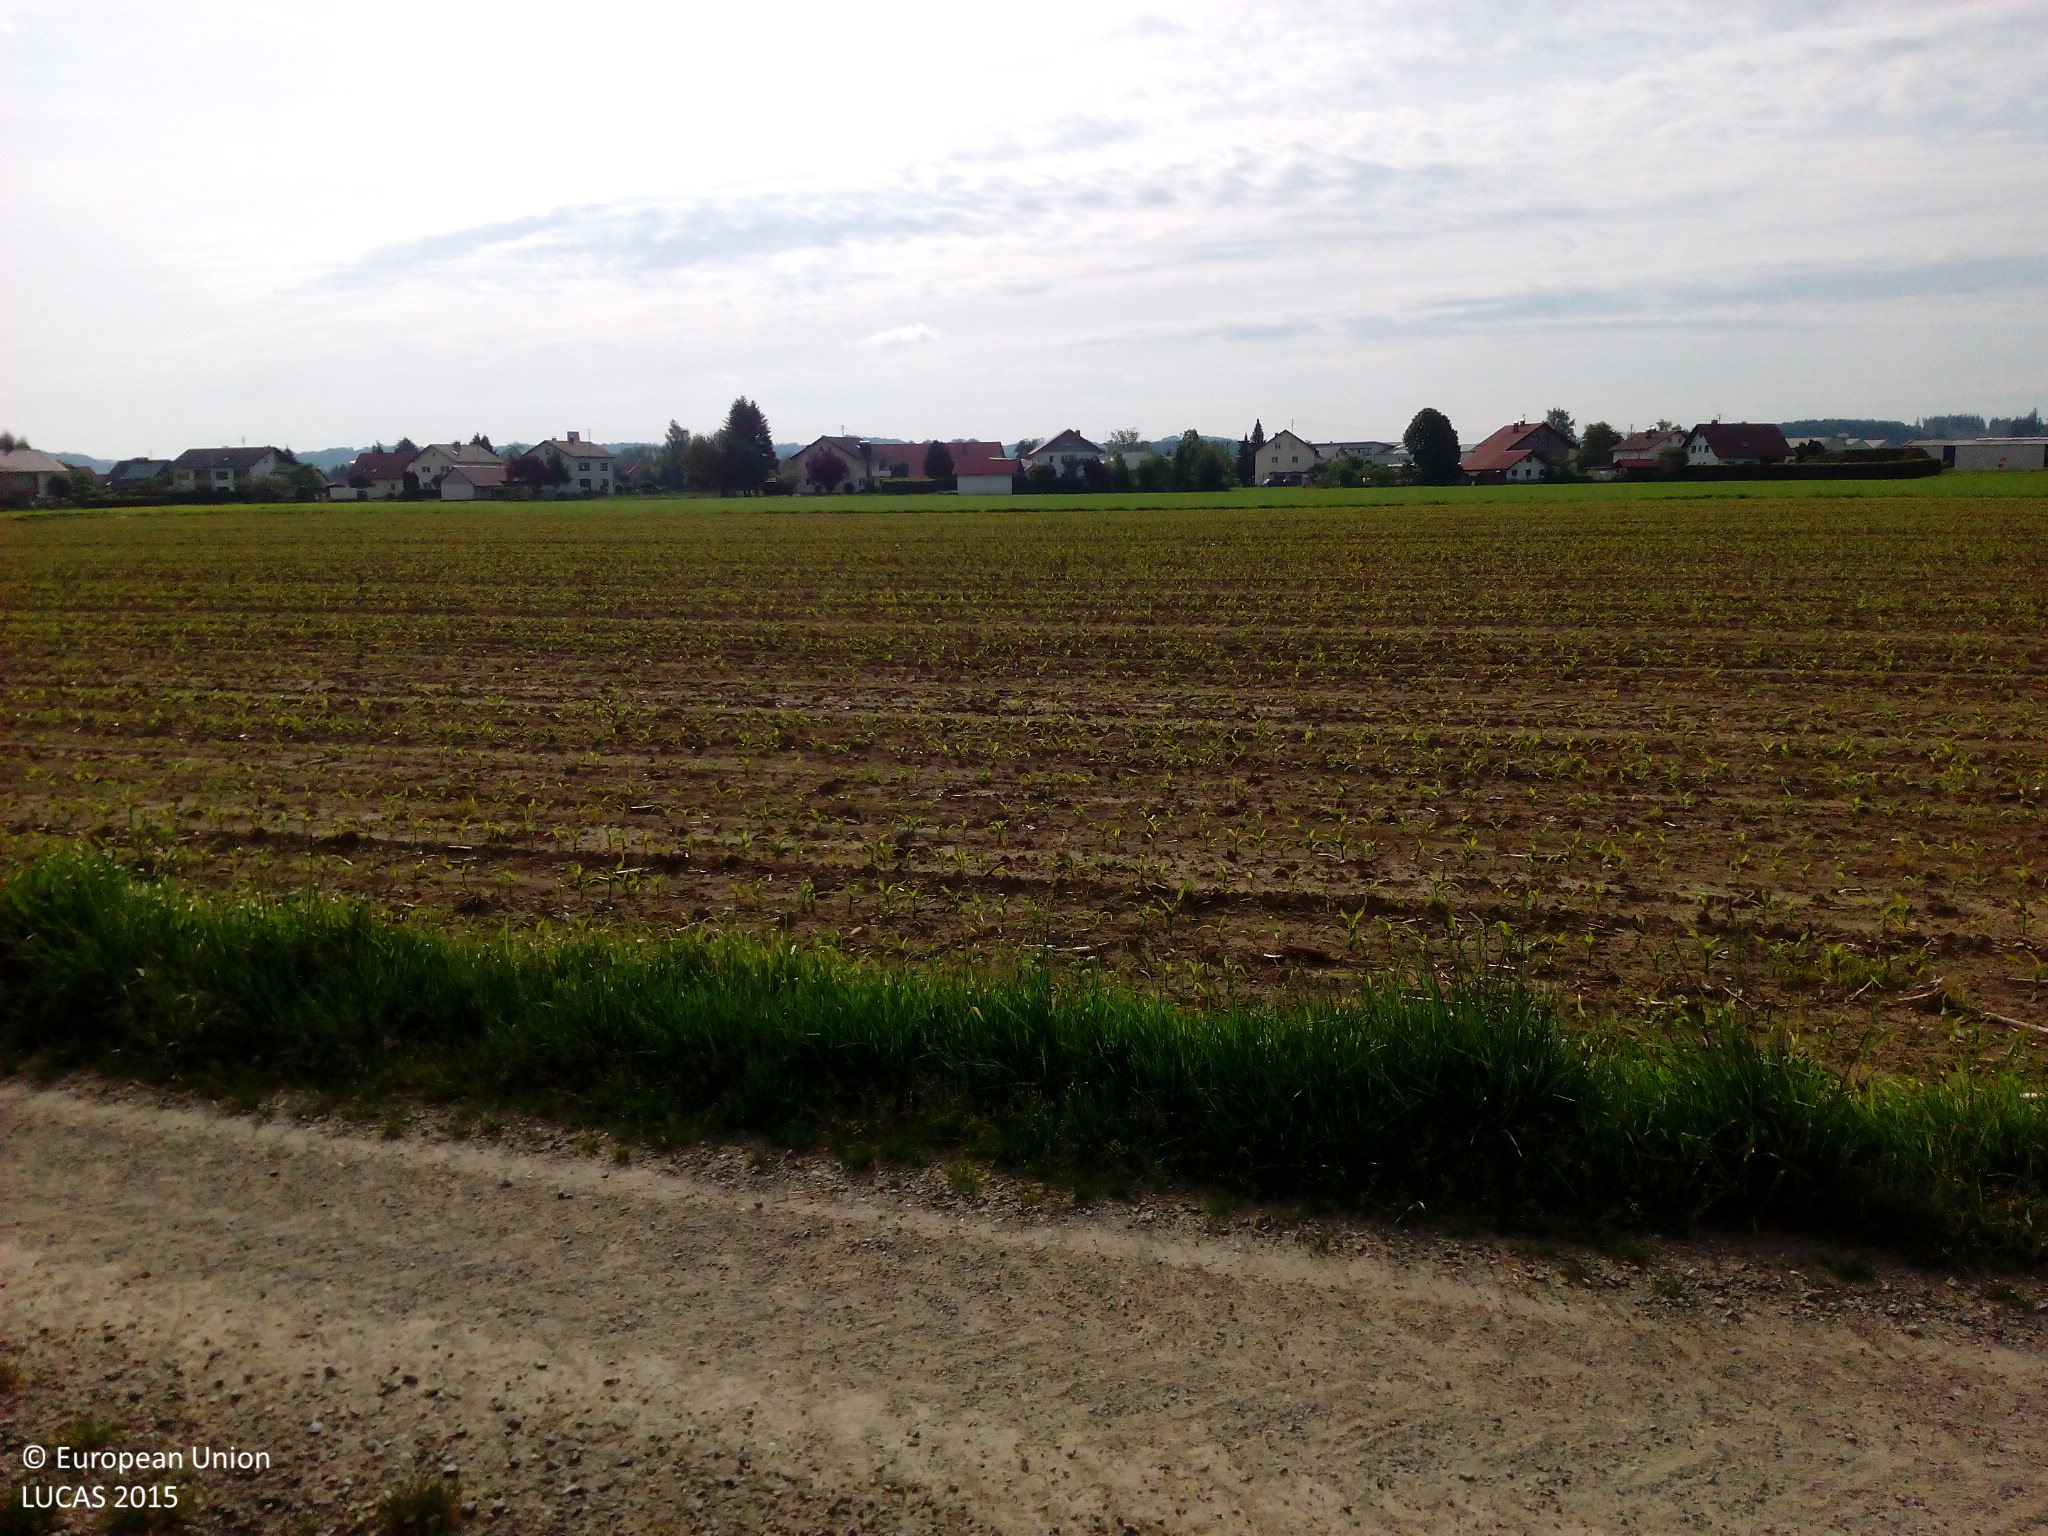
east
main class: Cropland
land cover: Common wheat
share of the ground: > 75 %
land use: Agriculture (excluding fallow land and kitchen gardens)
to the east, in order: Common wheat; Grass margins; Tracks; Grass margins; Maize; Grassland without tree/shrub cover; Maize
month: May
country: DE
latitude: 47.9713
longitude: 10.2543
